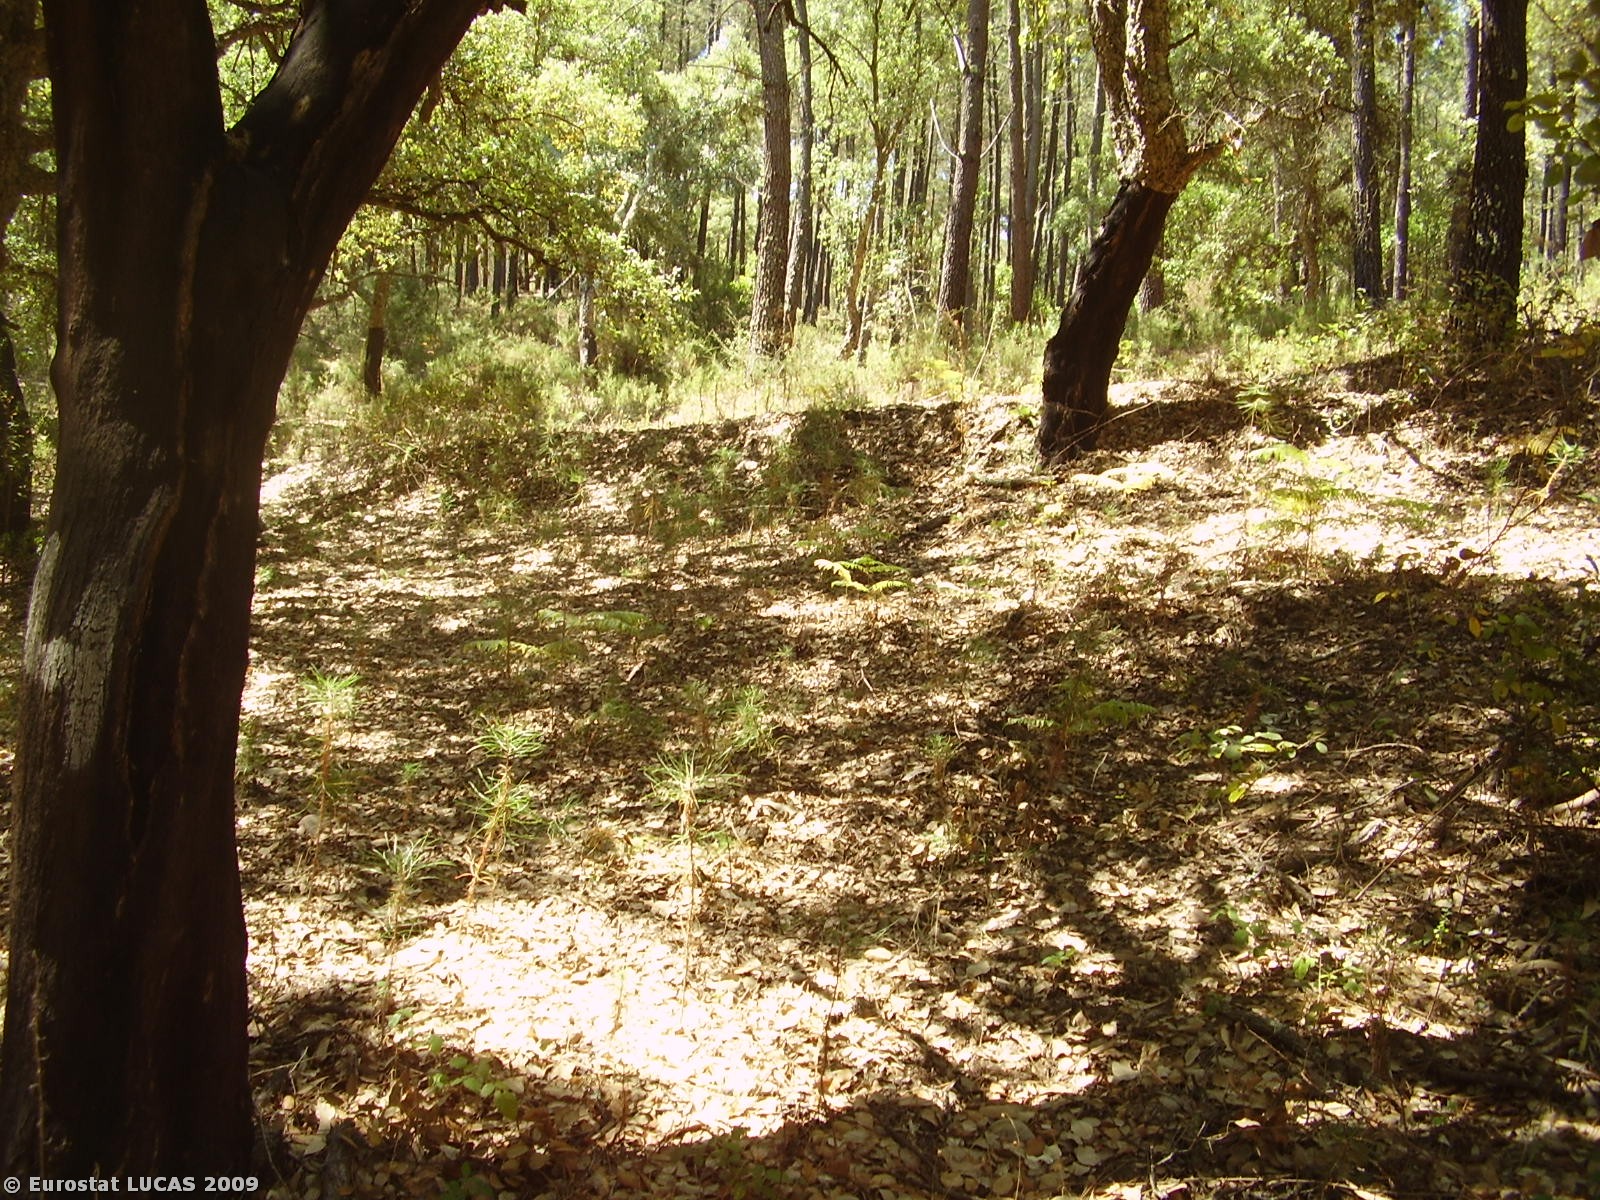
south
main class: Woodland
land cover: Broadleaved woodland
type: broadleaved evergreen forest
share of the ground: 50 - 75 %
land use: Forestry
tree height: > 5 m
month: July
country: PT
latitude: 39.4102
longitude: -8.2398
